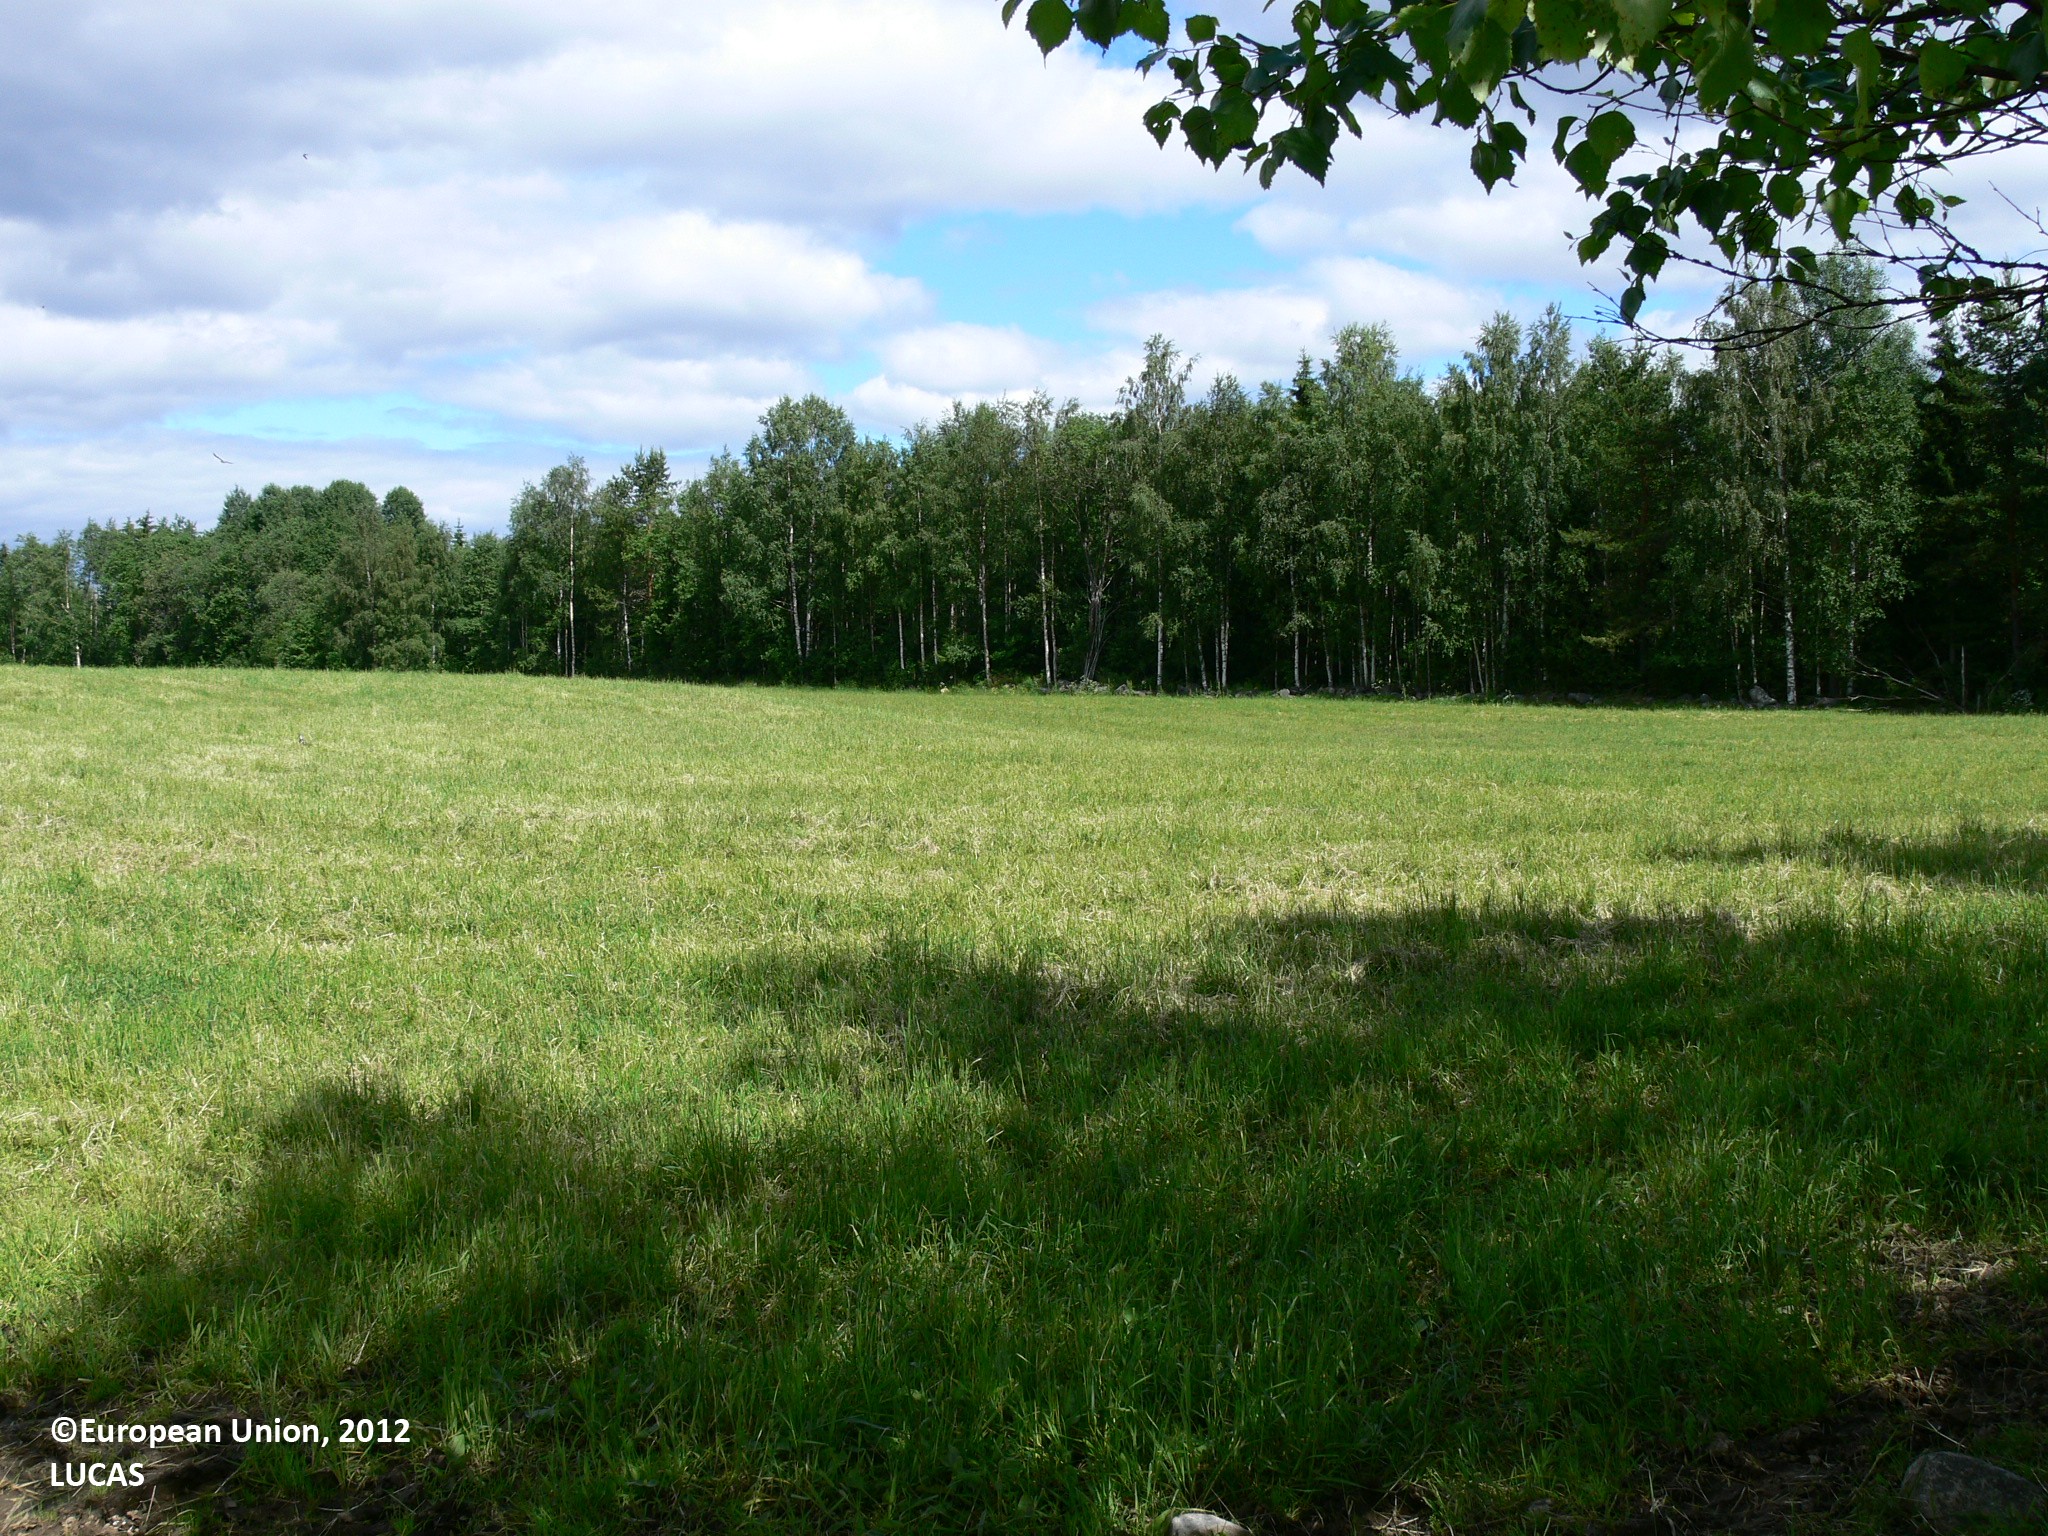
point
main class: Cropland
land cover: Temporary grasslands
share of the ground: 25 - 50 %
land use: Agriculture (excluding fallow land and kitchen gardens)
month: June
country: FI
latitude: 62.7197
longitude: 30.7268
